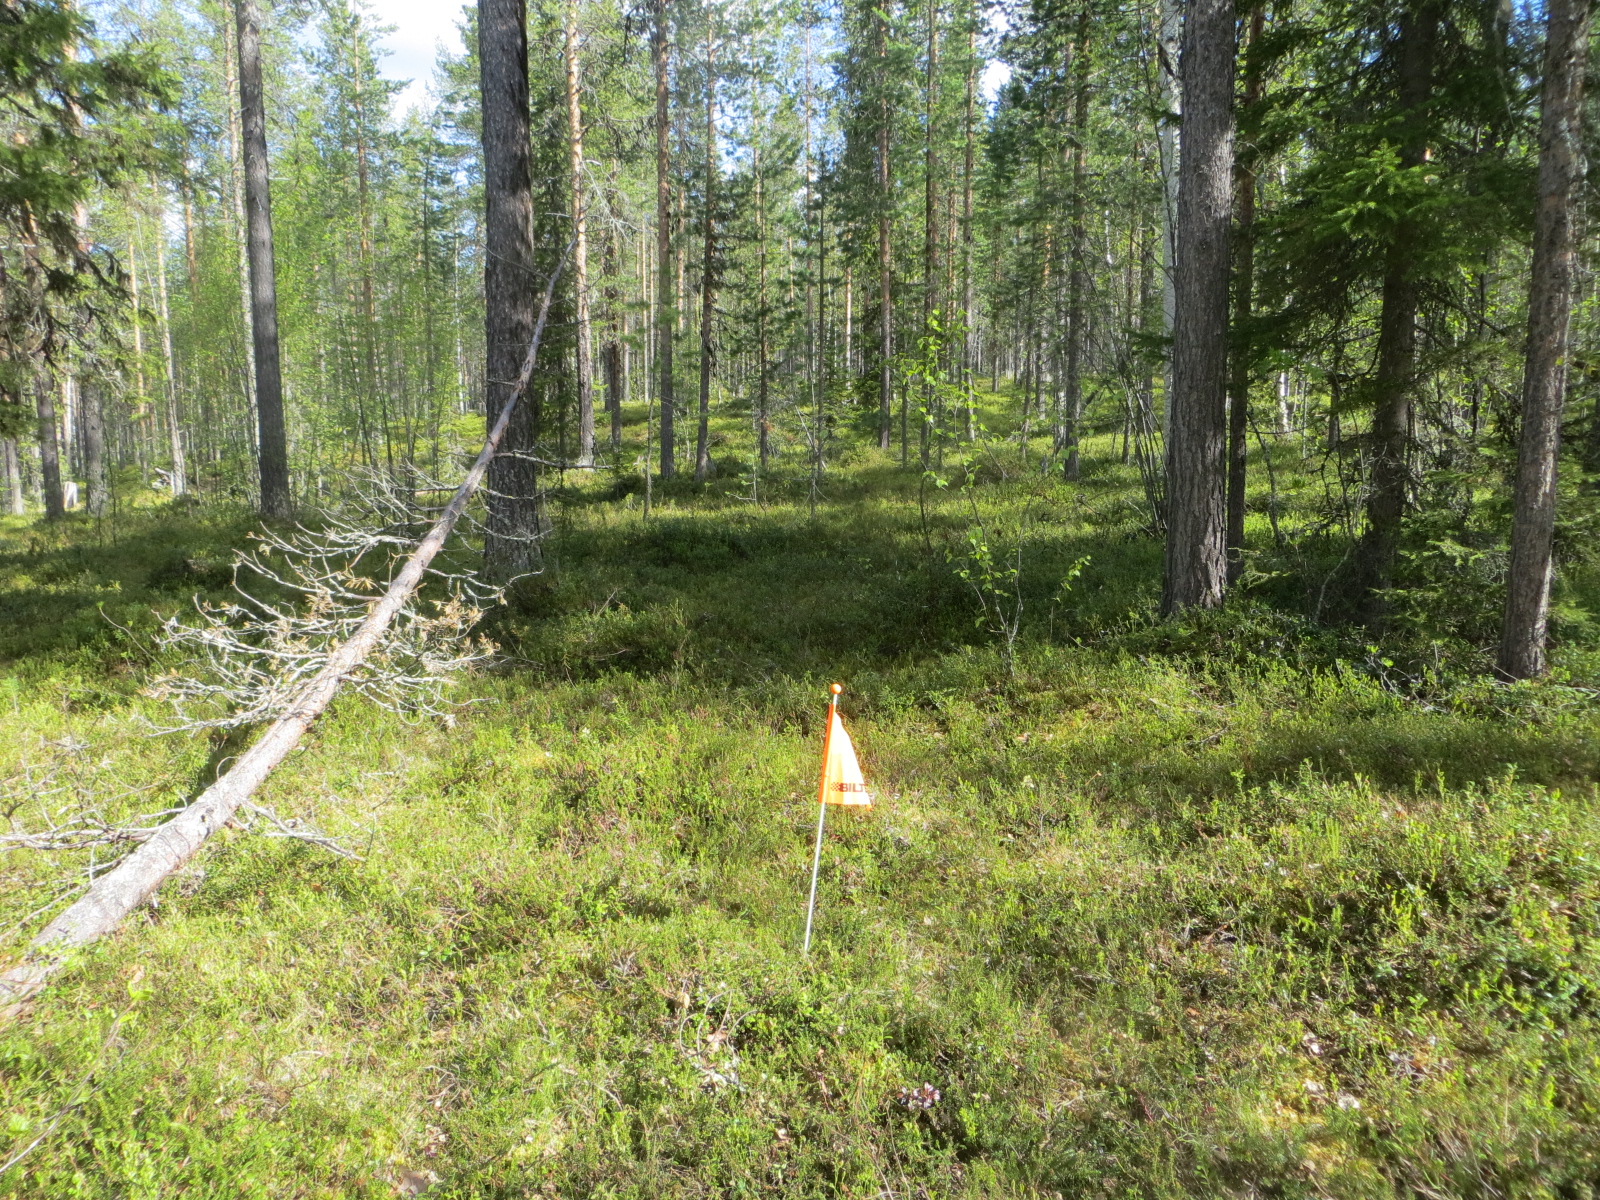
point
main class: Woodland
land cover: Pine dominated mixed woodland
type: boreal forest
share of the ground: 50 - 75 %
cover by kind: coniferous forest trees 50 %, shrubs 30 %, broadleaved forest trees 20 %
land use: Forestry
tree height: > 5 m
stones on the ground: 25 - 50 %
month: June
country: FI
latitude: 67.6149
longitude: 25.2668
